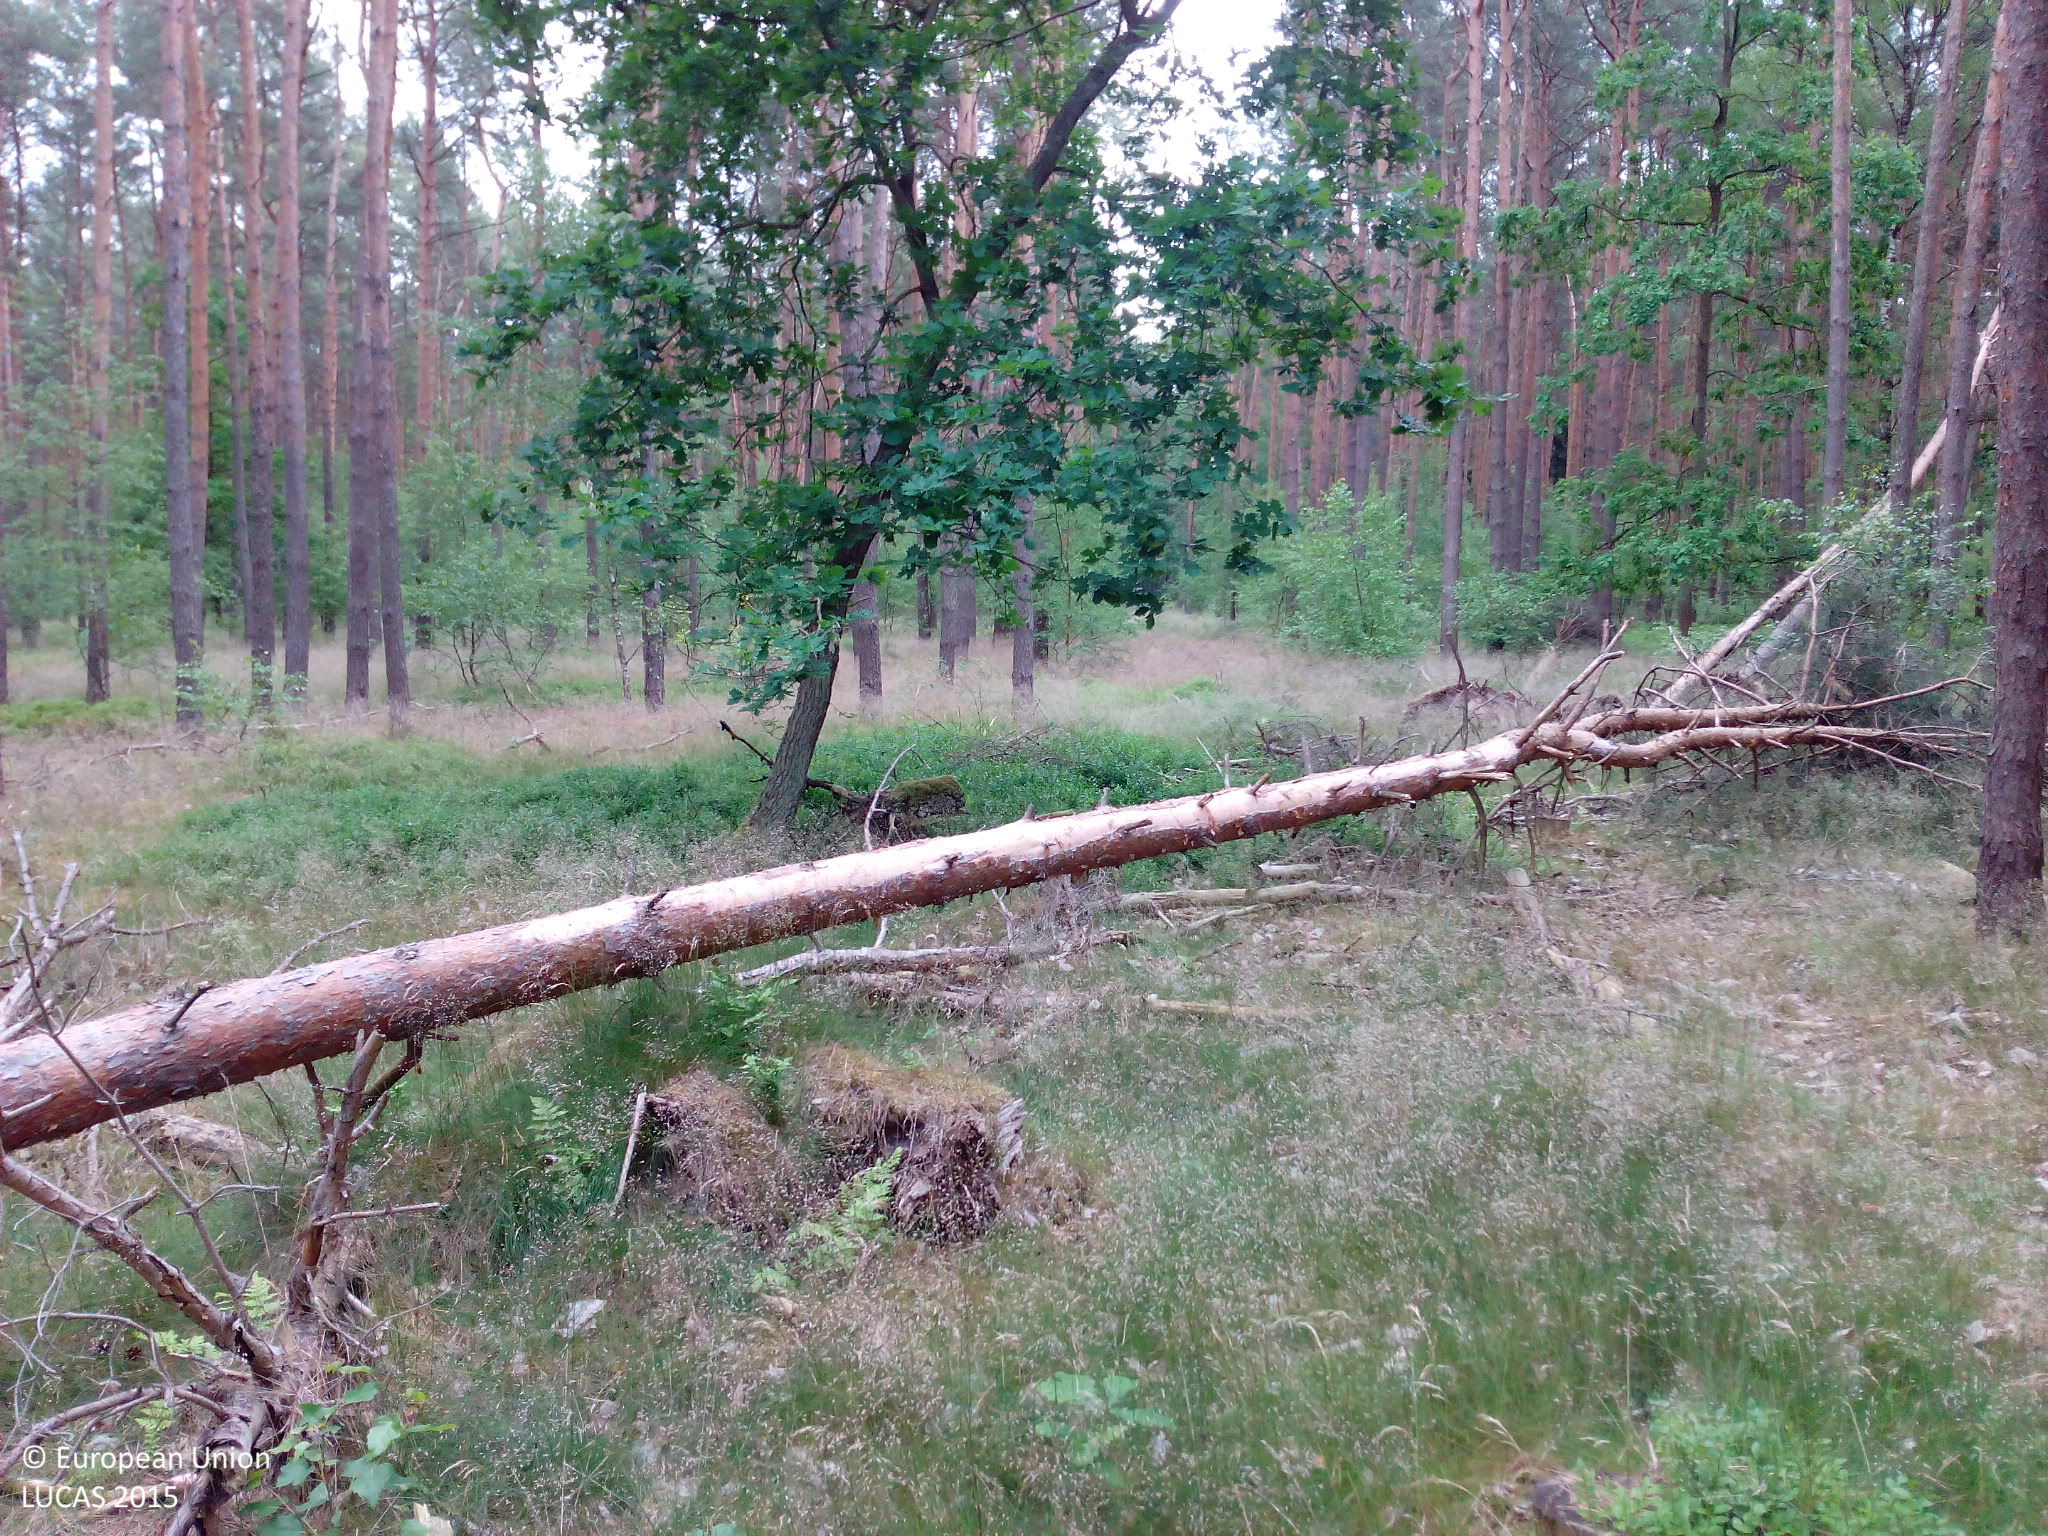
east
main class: Woodland
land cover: Pine dominated coniferous woodland
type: hemiboreal forest and nemoral coniferous forest and mixed broadleaved-coniferous forest
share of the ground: 50 - 75 %
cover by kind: coniferous forest trees 50 %, herbaceous plants 20 %, broadleaved forest trees 10 %, shrubs 10 %, lichens and mosses 10 %
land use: Forestry
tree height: > 5 m
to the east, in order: Pine dominated coniferous woodland; Tracks; Pine dominated coniferous woodland; Pine dominated mixed woodland
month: June
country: DE
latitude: 52.5689
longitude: 12.4044
